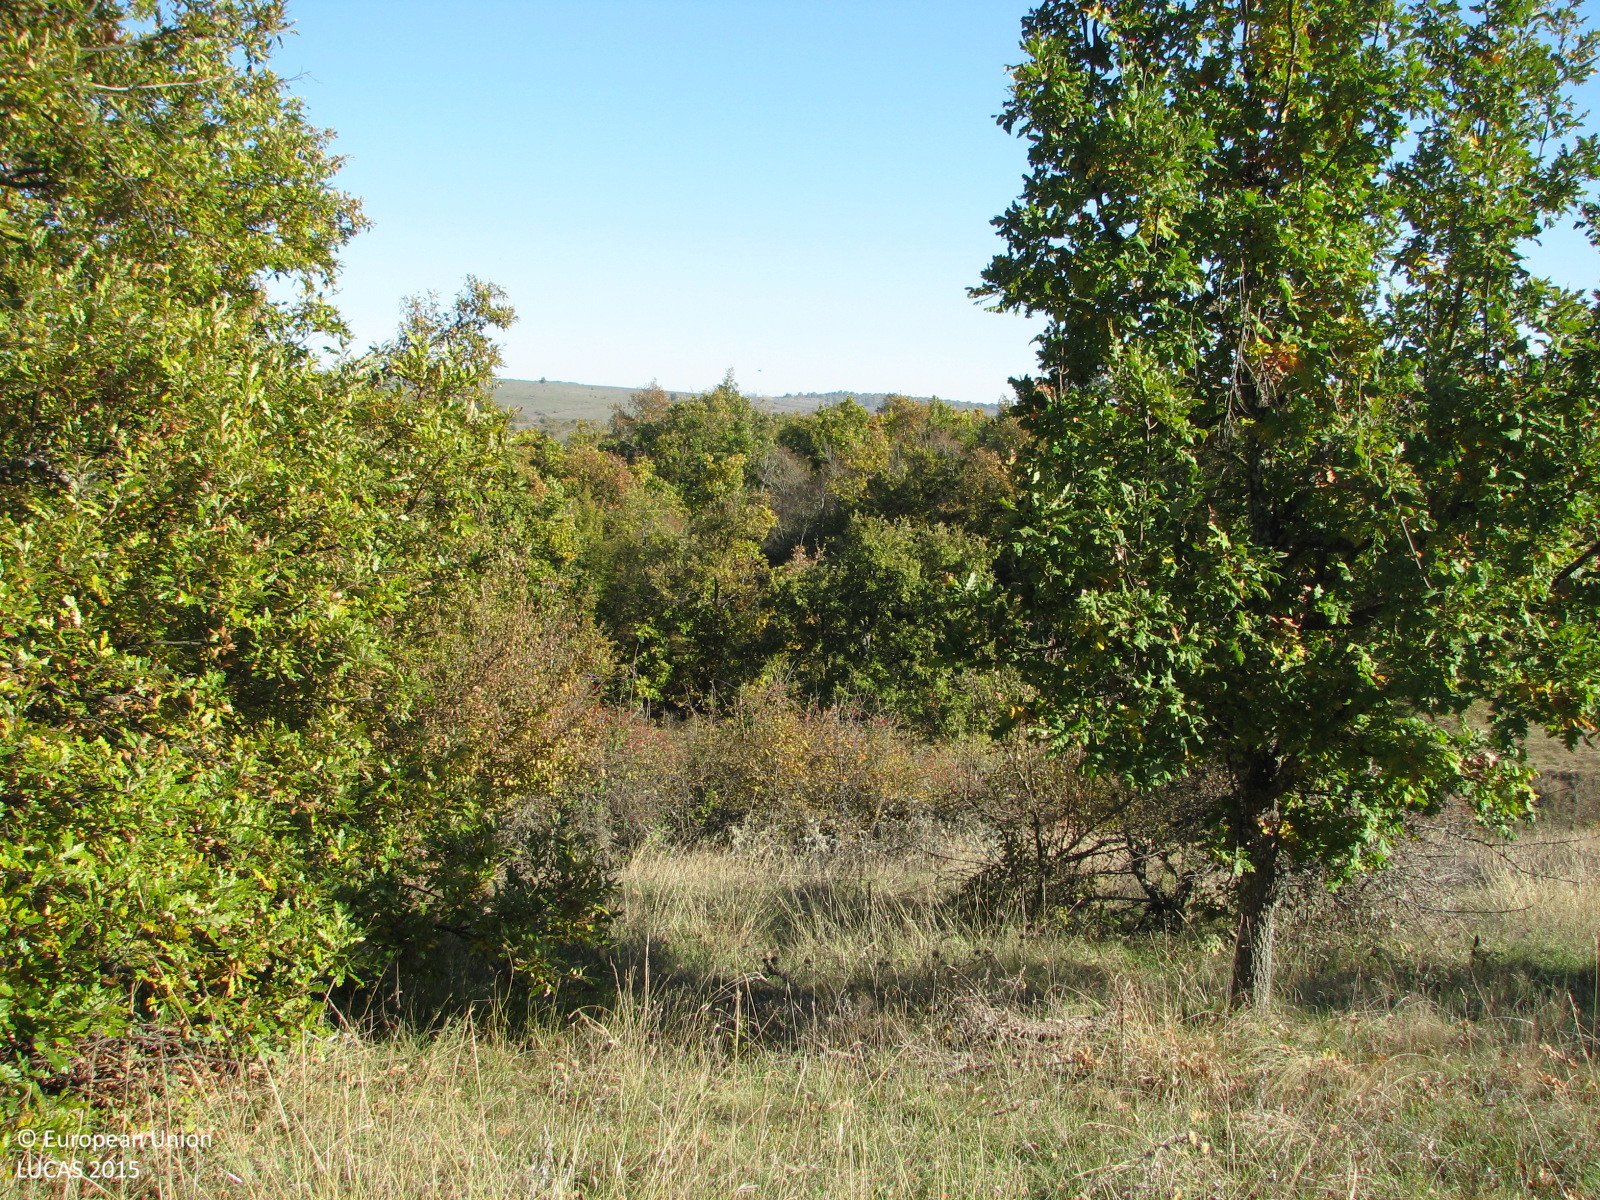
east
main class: Grassland
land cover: Grassland with sparse tree/shrub cover
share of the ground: > 75 %
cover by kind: herbaceous plants 85 %, shrubs 10 %, broadleaved forest trees 5 %
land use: Semi-natural and natural areas not in use
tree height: < 5 m
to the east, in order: Grassland with sparse tree/shrub cover; Broadleaved woodland; Grassland with sparse tree/shrub cover; Broadleaved woodland
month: November
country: BG
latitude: 42.0594
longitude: 26.9547
